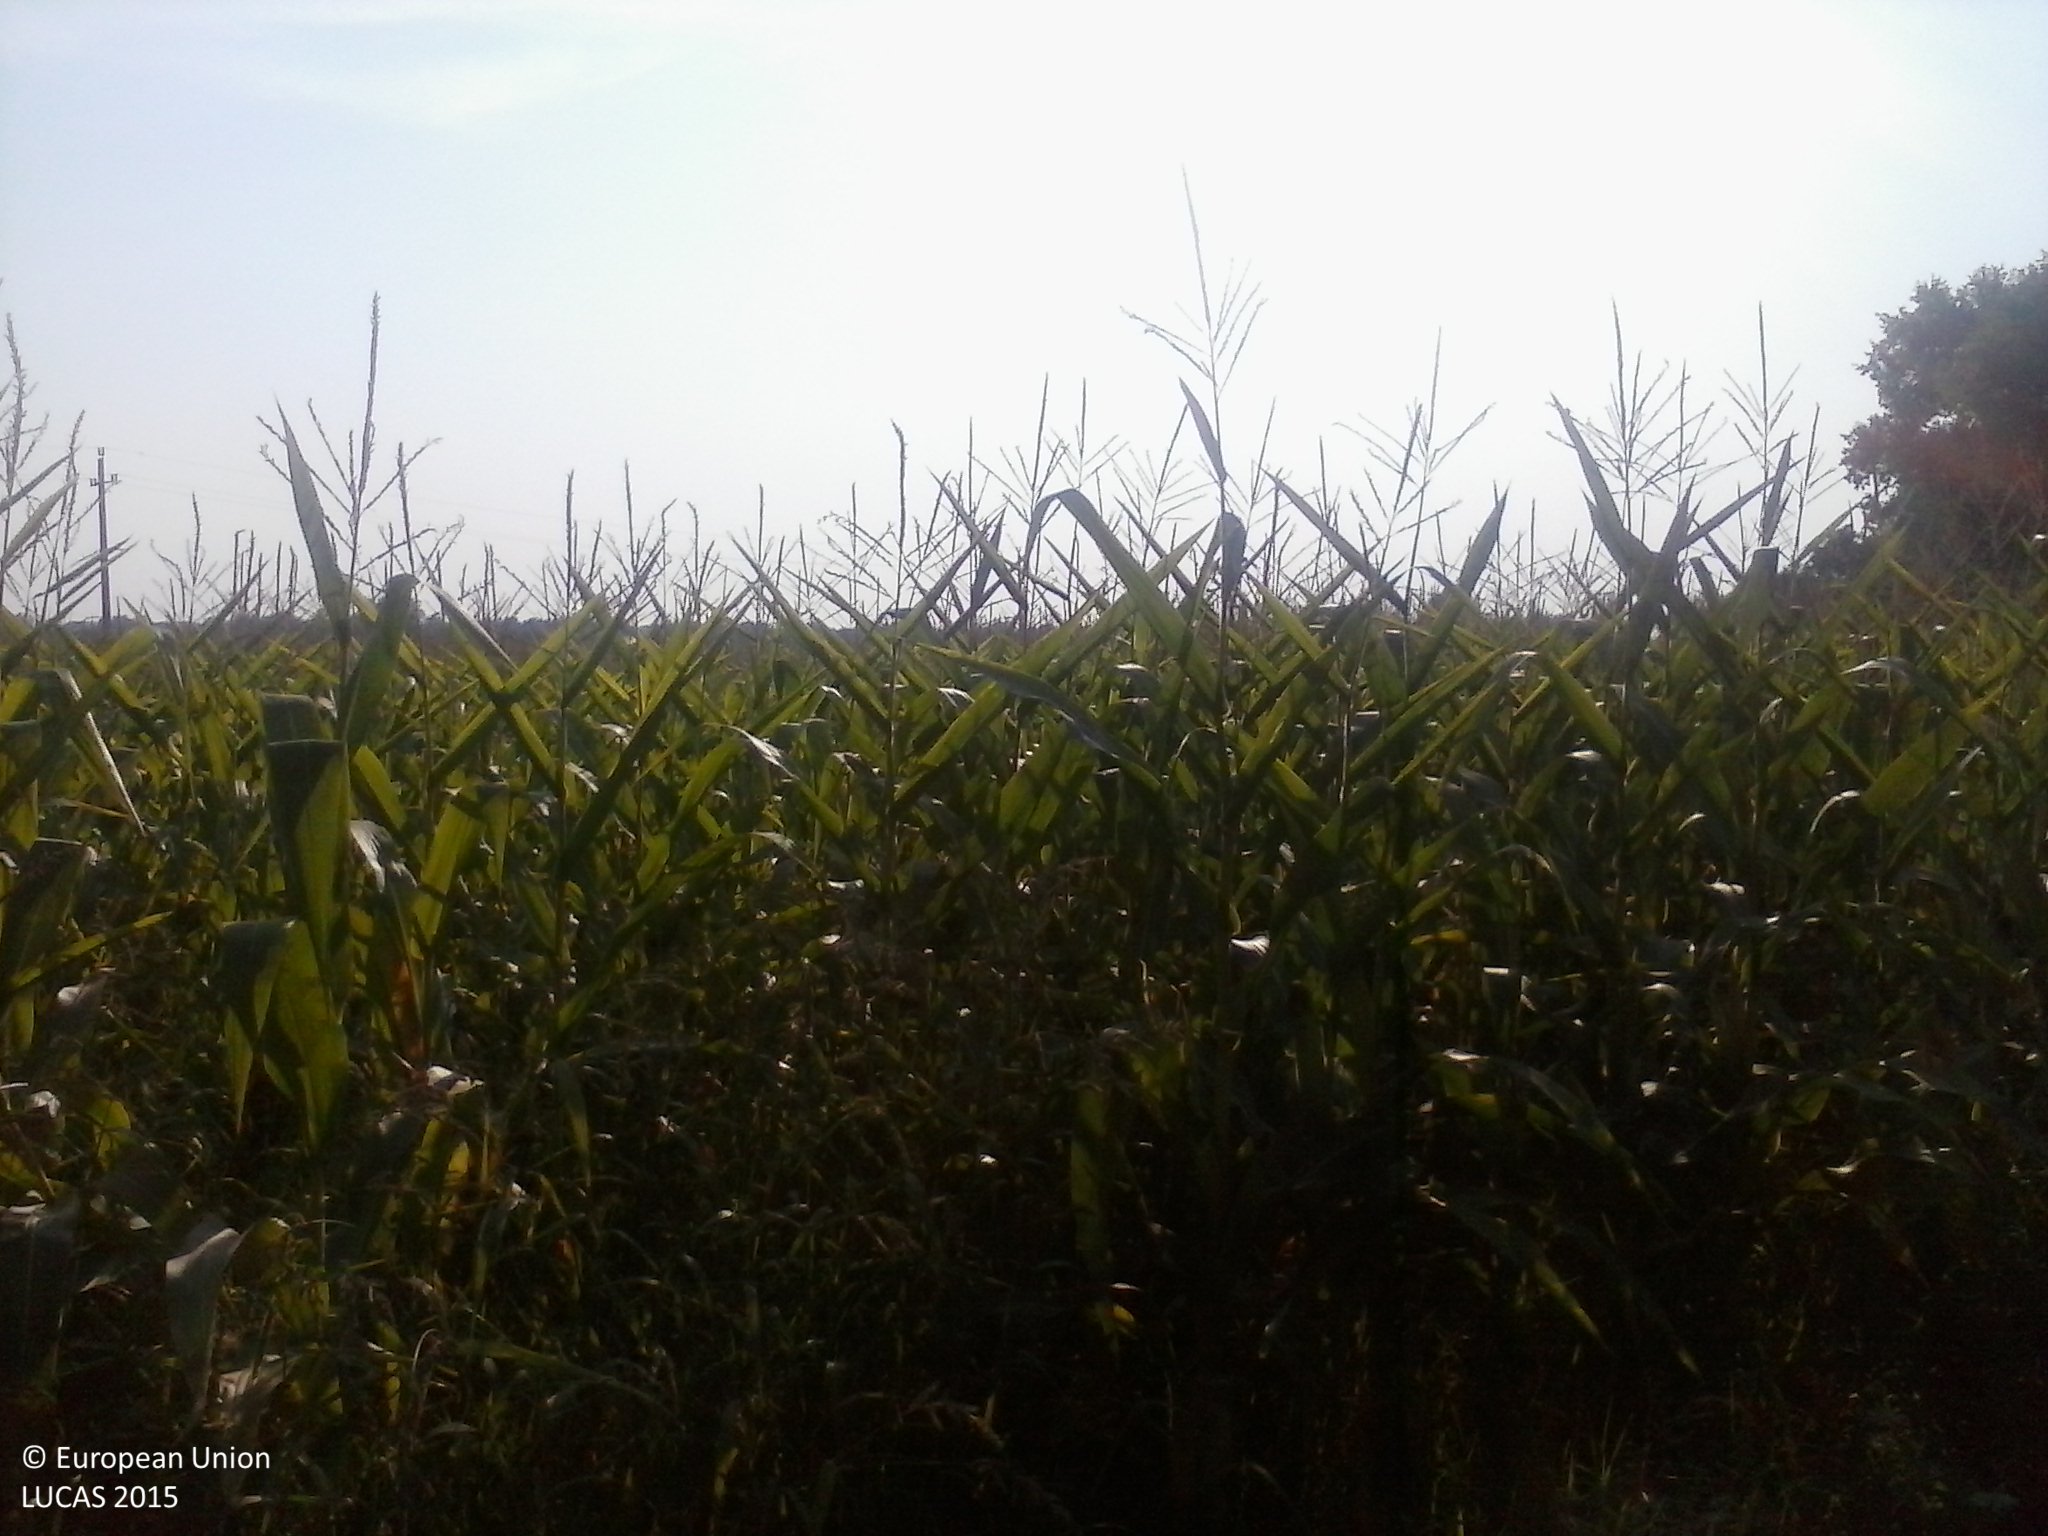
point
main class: Cropland
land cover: Maize
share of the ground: > 75 %
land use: Agriculture (excluding fallow land and kitchen gardens)
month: August
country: HU
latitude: 45.9037
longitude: 18.0360
